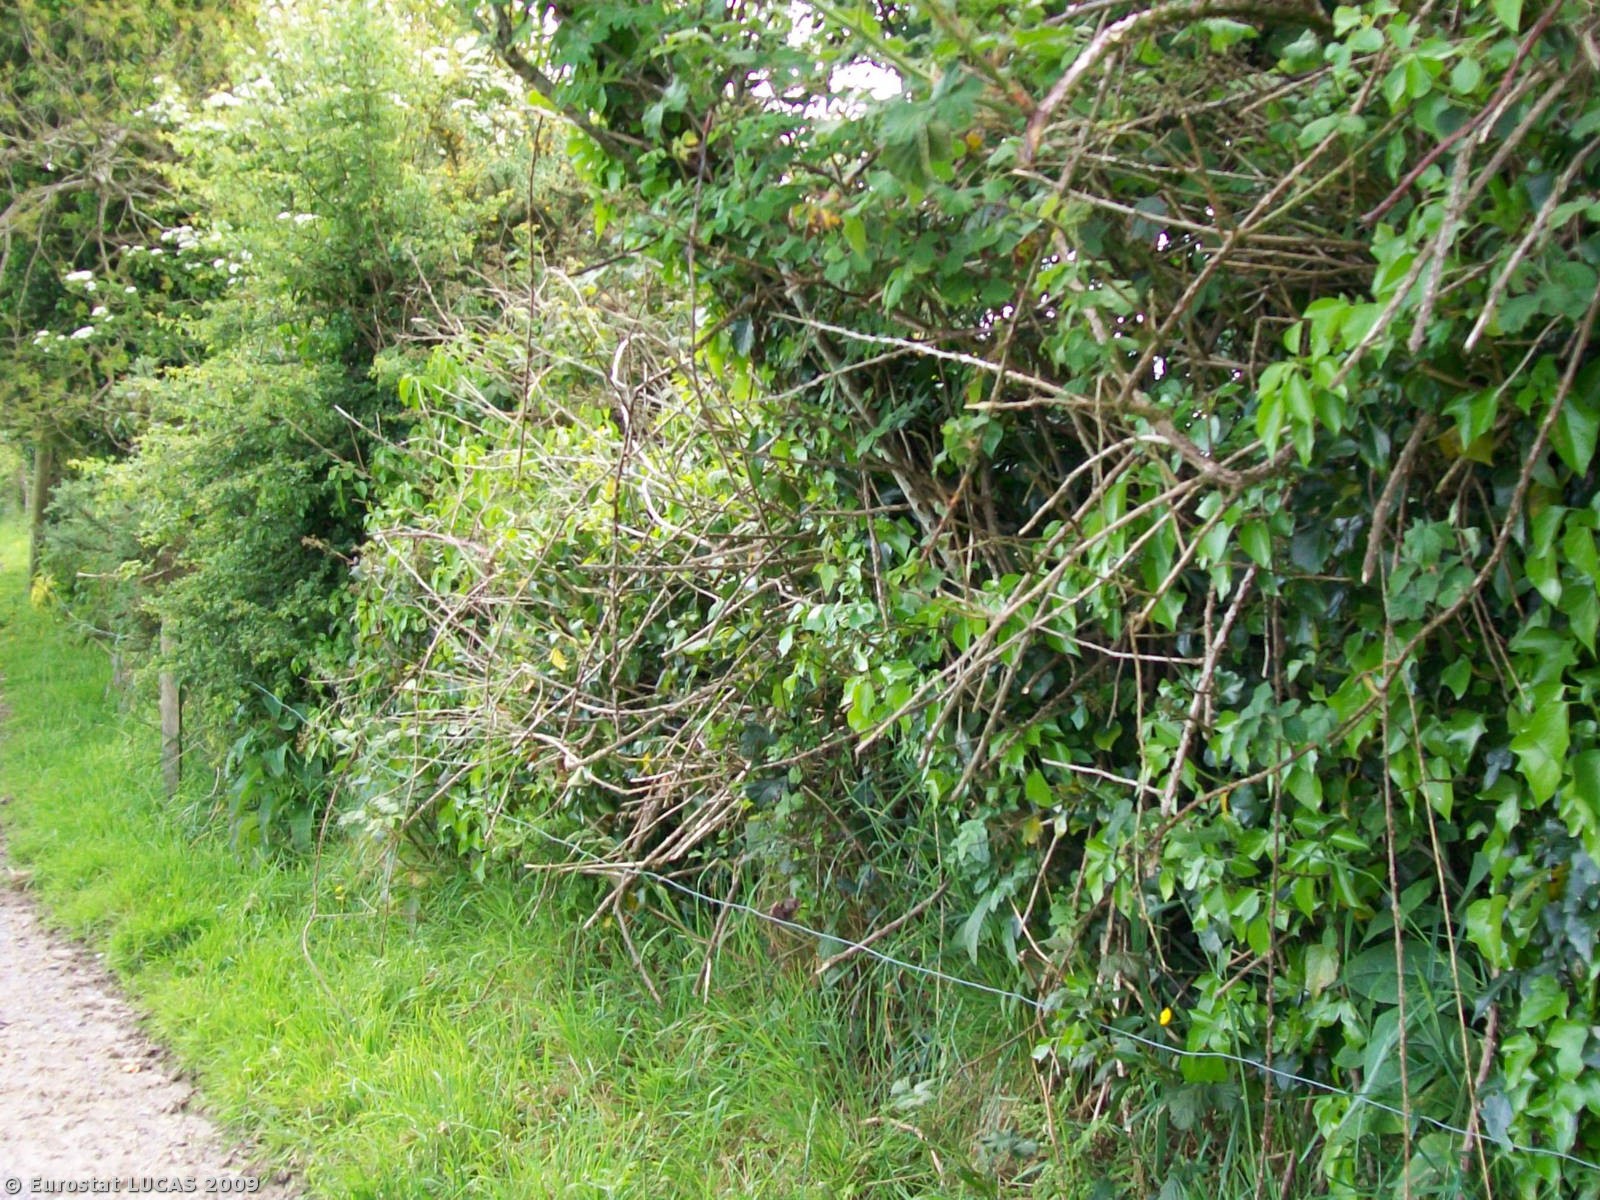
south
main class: Grassland
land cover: Grassland without tree/shrub cover
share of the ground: > 75 %
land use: Agriculture (excluding fallow land and kitchen gardens)
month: May
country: IE
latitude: 51.7837
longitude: -8.7735
